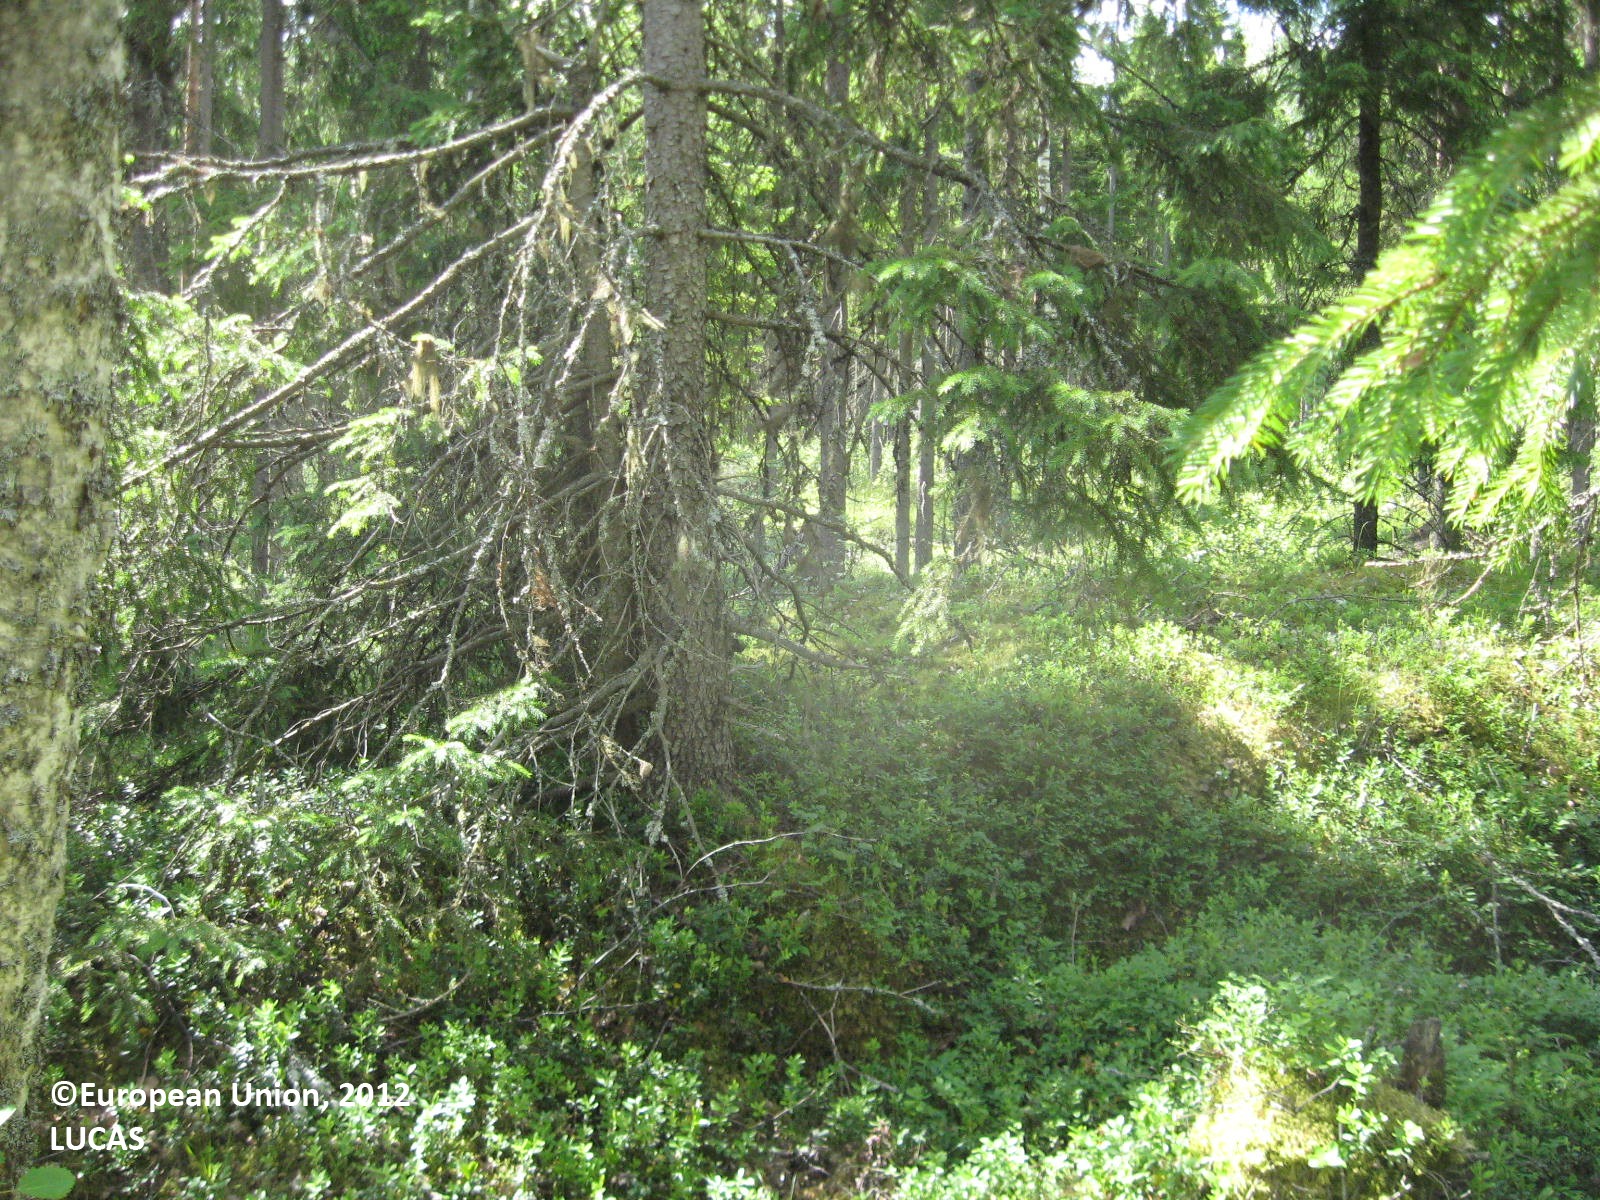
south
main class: Woodland
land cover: Spruce dominated mixed woodland
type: boreal forest
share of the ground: 50 - 75 %
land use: Forestry
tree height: > 5 m
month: July
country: FI
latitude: 62.6270
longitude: 22.6311
